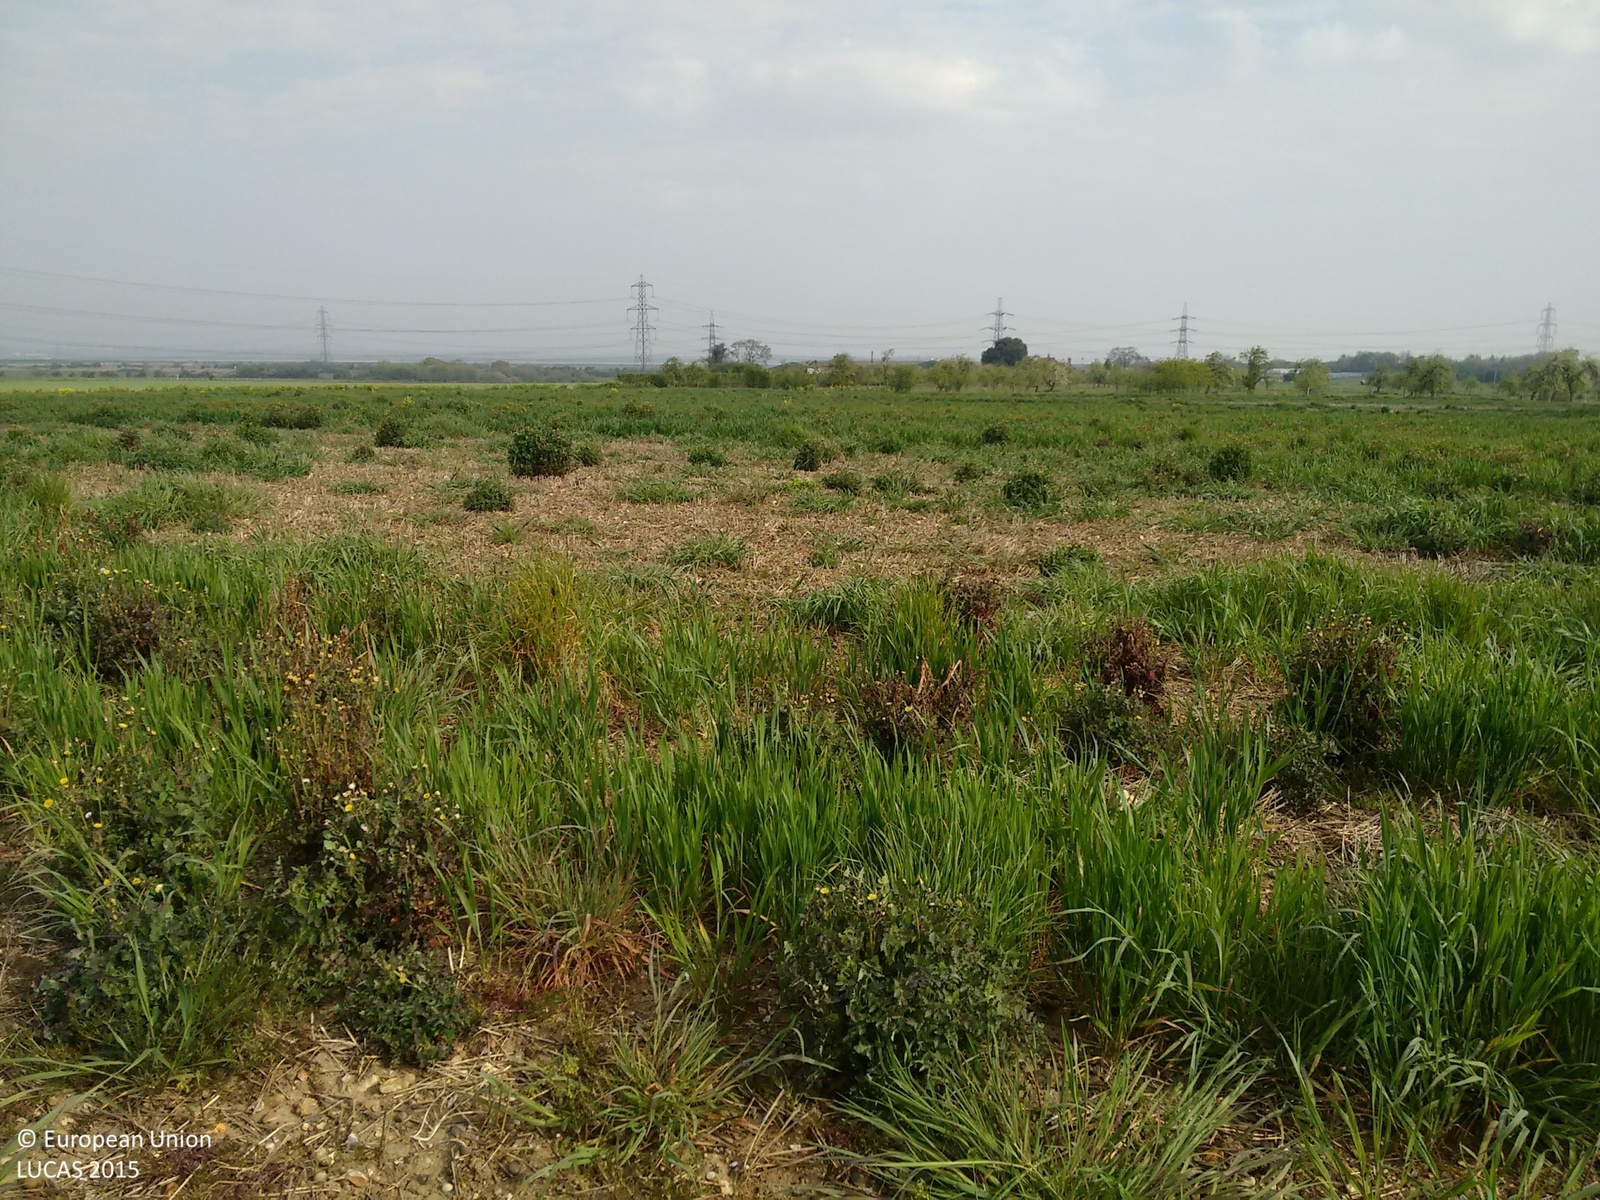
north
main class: Grassland
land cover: Spontaneously vegetated surfaces
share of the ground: 50 - 75 %
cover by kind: herbaceous plants 50 %, unconsolidated bare surface 50 %
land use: Fallow land
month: April
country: GB
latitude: 51.4292
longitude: 0.4355
